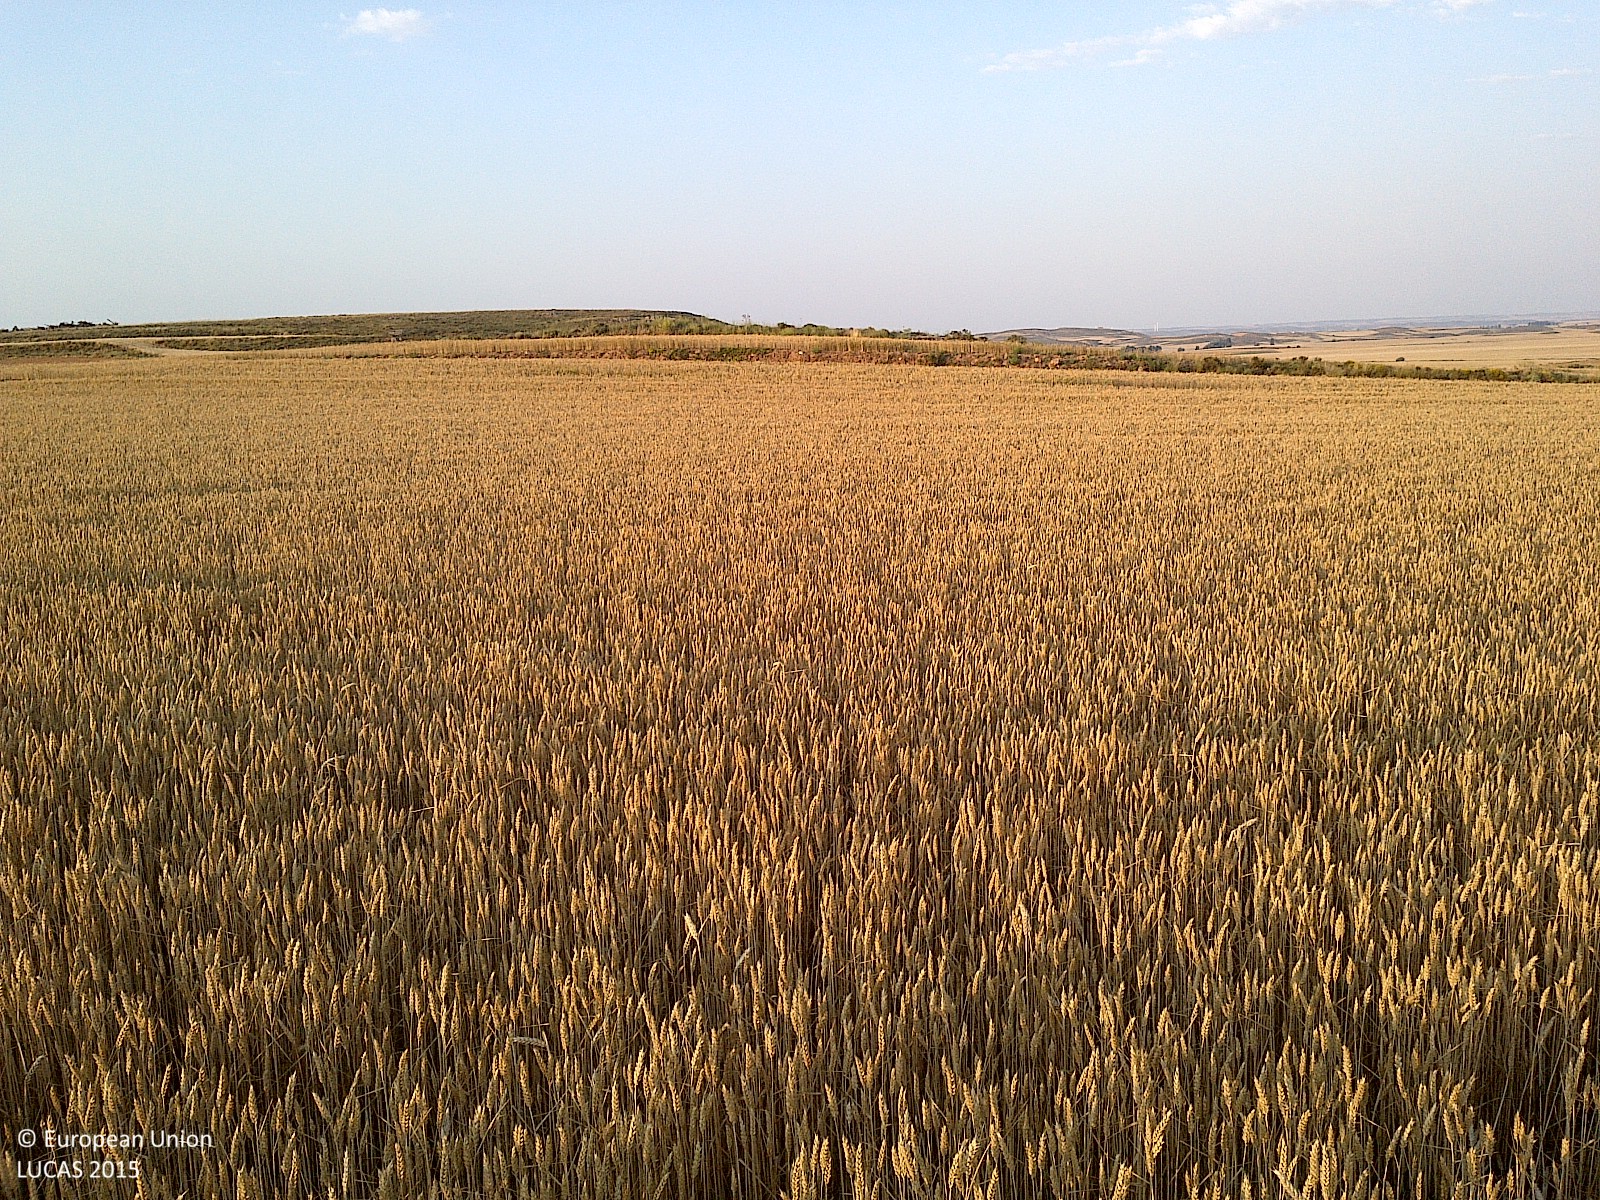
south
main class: Cropland
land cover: Common wheat
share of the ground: > 75 %
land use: Agriculture (excluding fallow land and kitchen gardens)
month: June
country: ES
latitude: 41.6910
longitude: -2.2296
